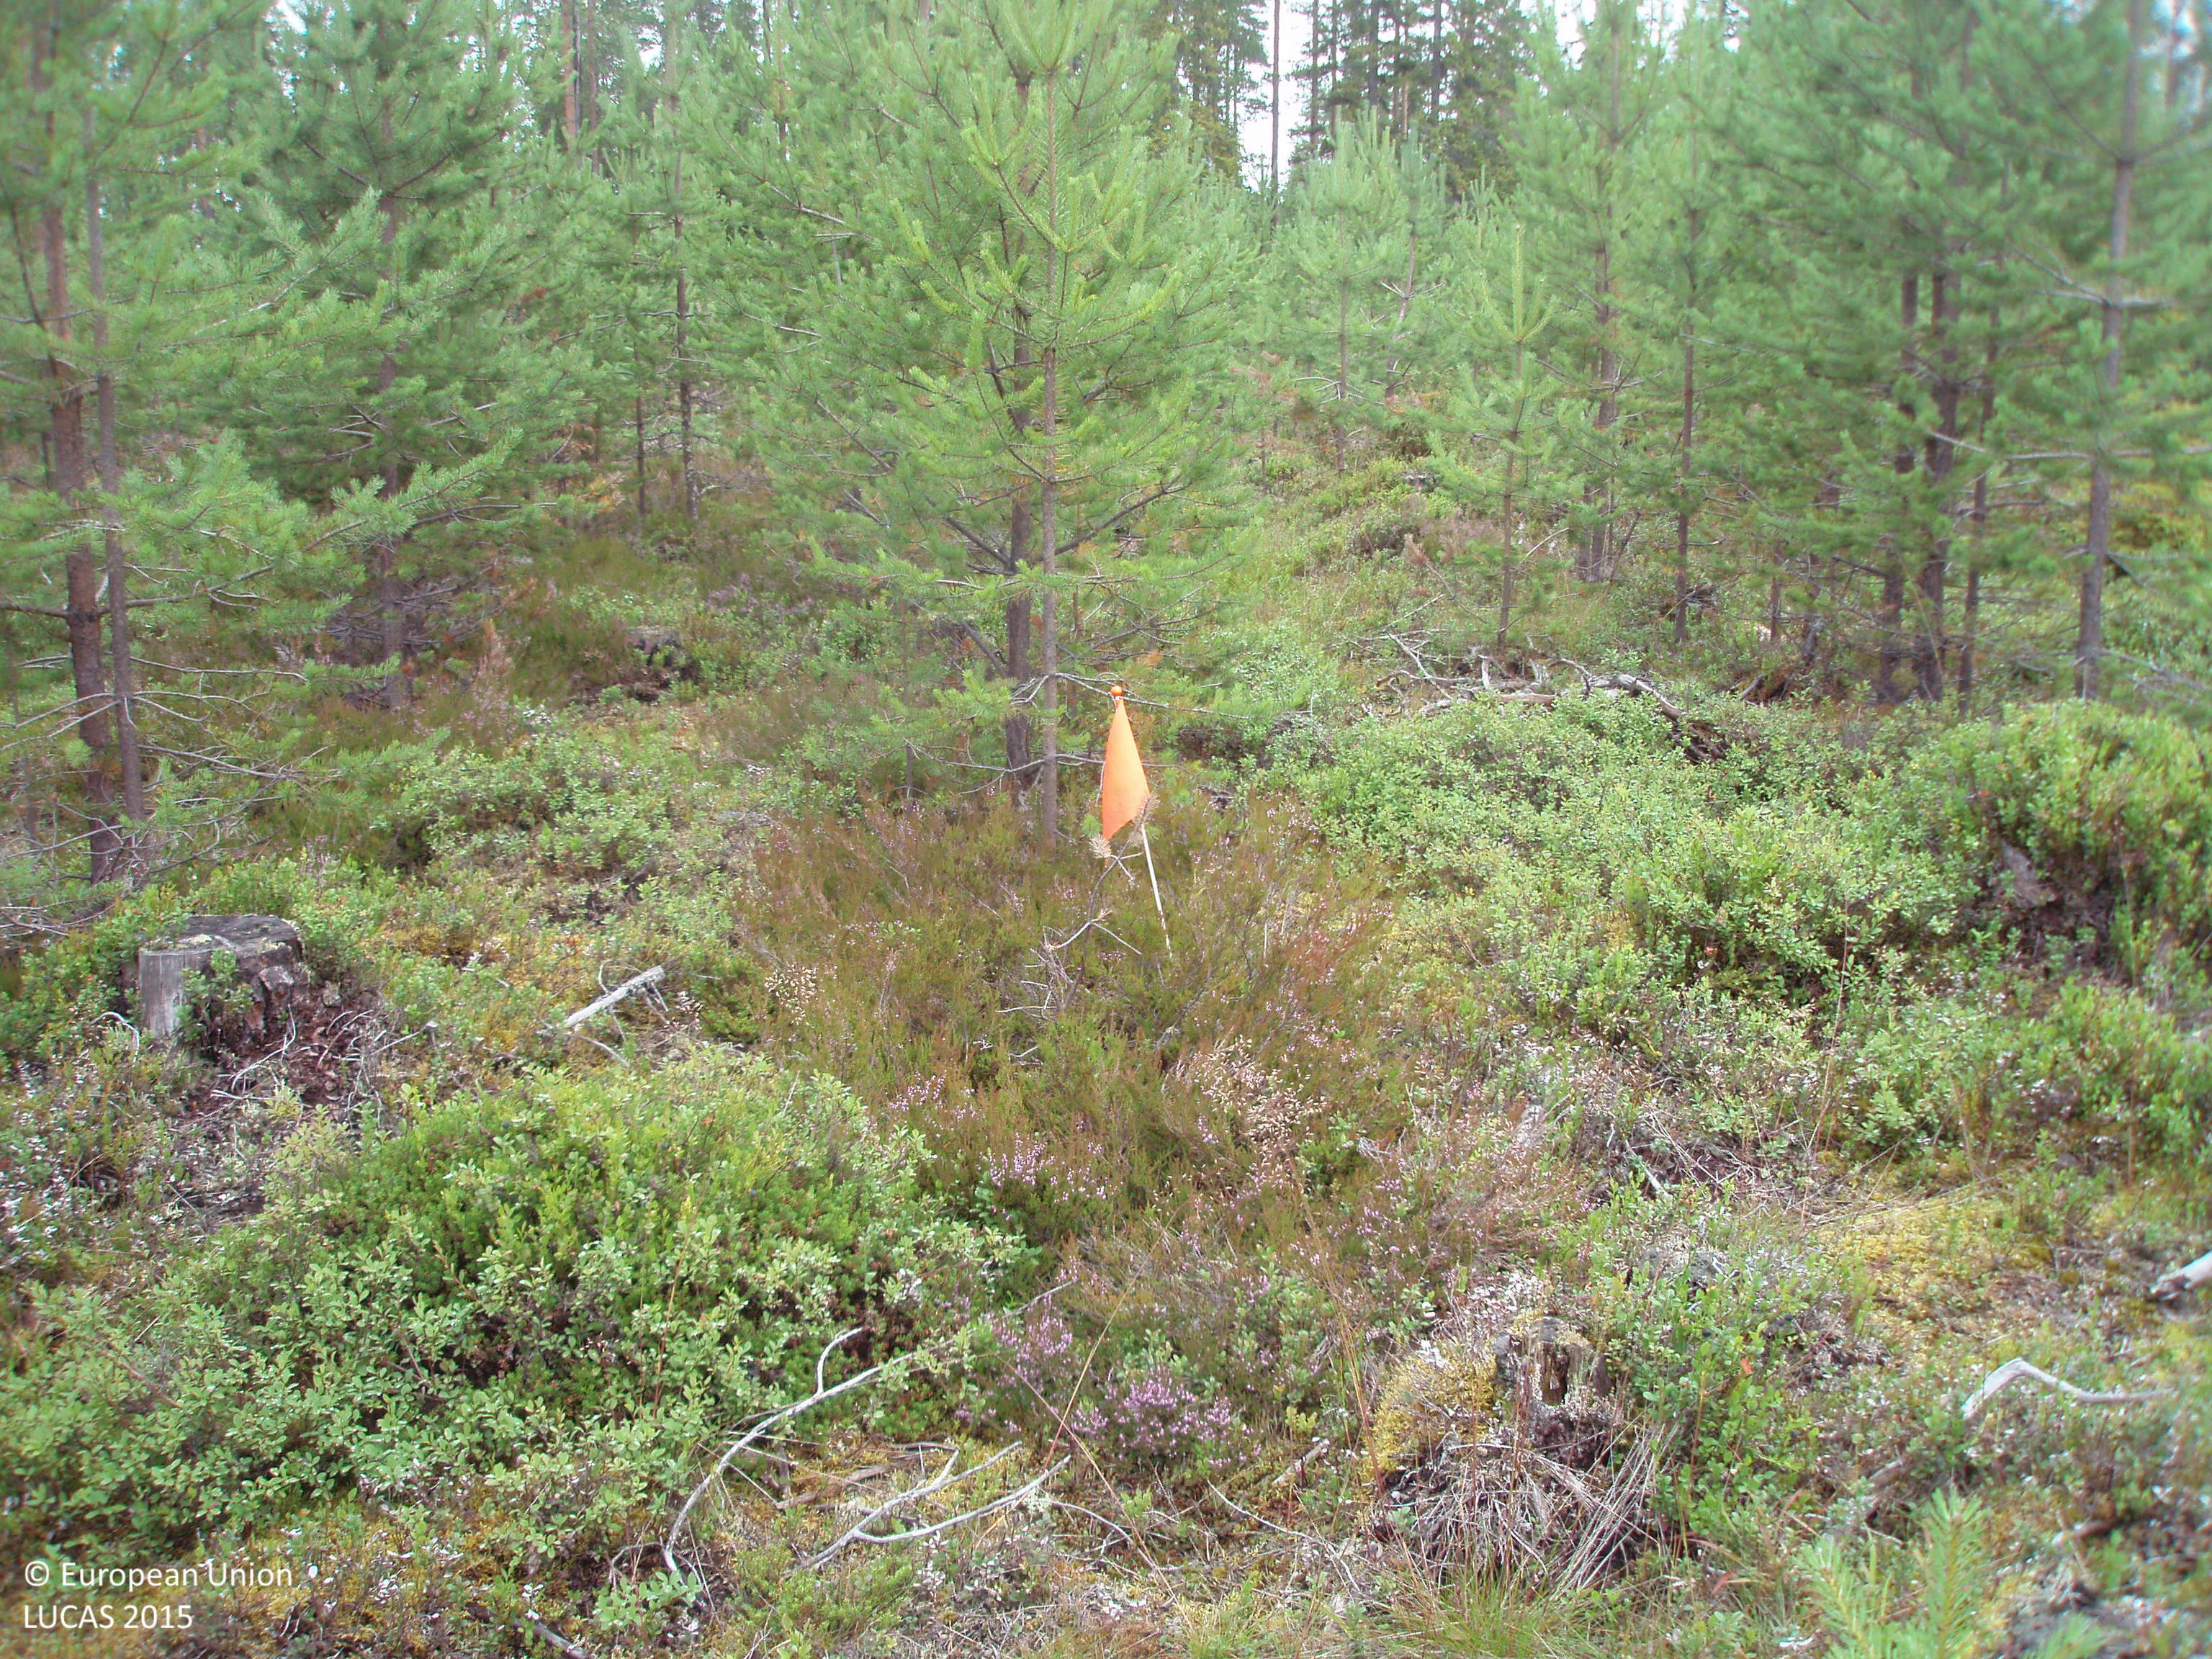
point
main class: Woodland
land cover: Pine dominated coniferous woodland
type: boreal forest
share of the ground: 25 - 50 %
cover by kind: shrubs 65 %, coniferous forest trees 35 %
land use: Forestry
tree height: < 5 m
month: August
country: FI
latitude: 65.4930
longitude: 27.0329
